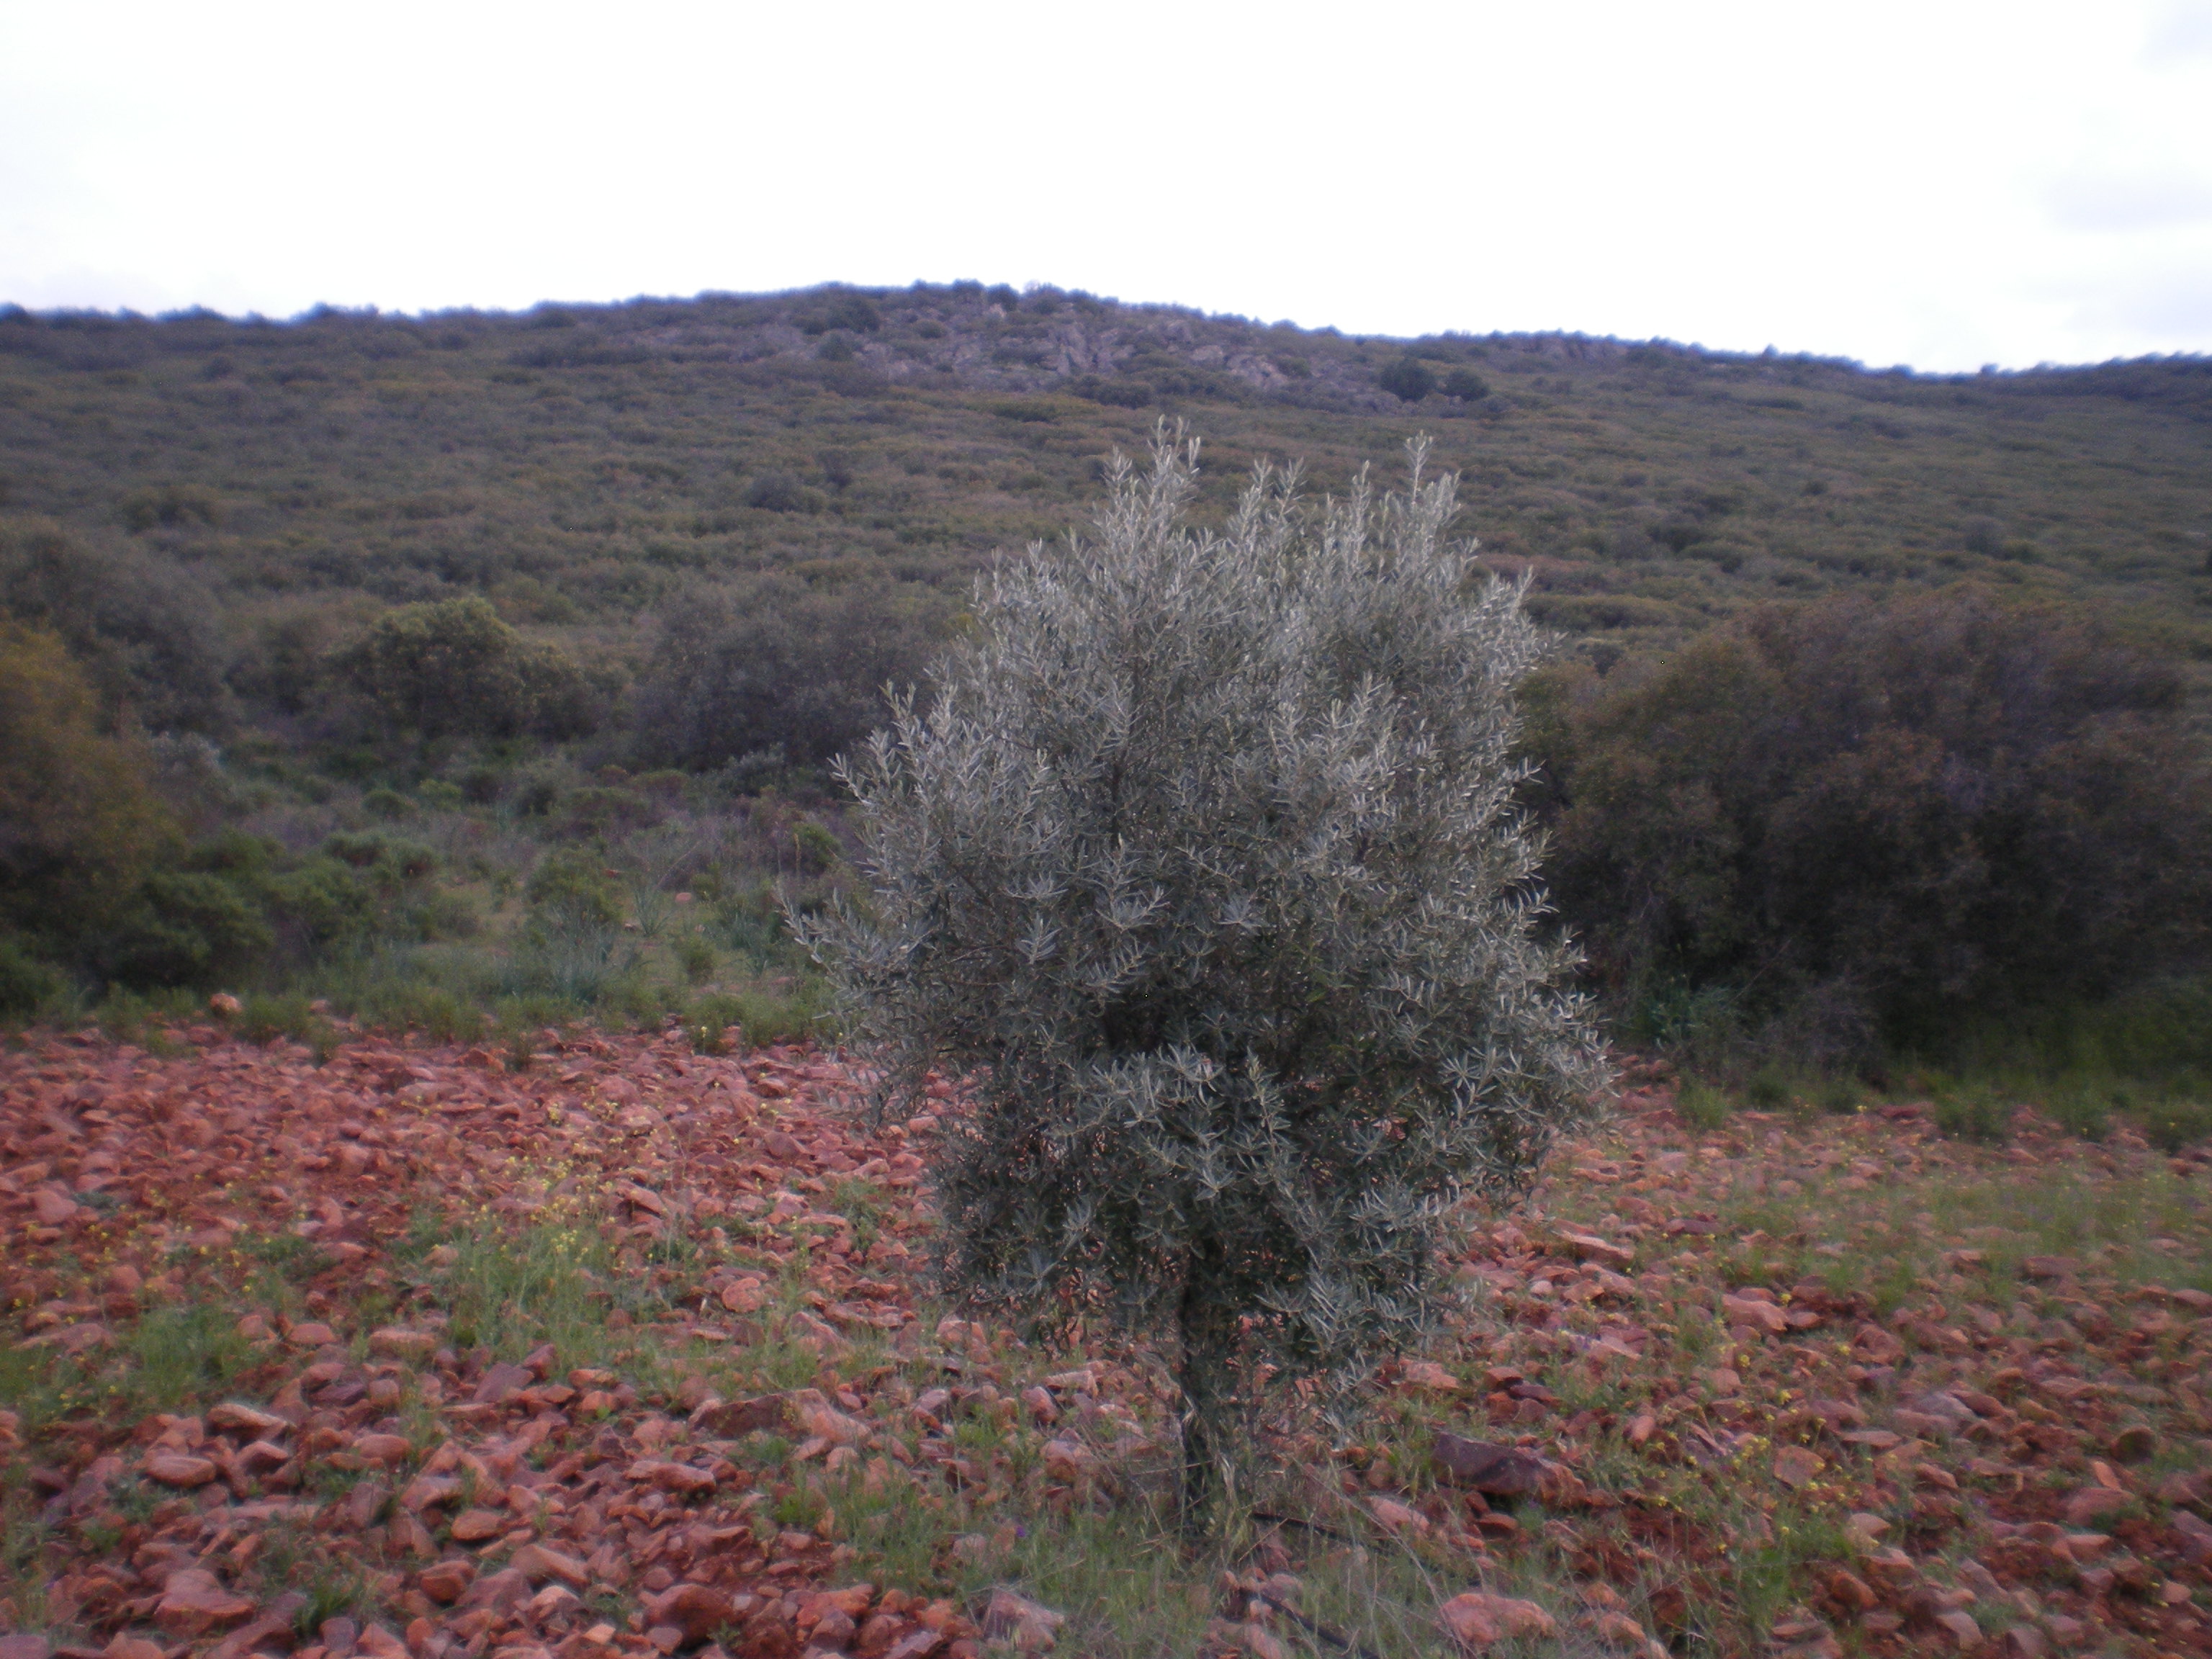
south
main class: Cropland
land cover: Olive groves
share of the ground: 10 - 25 %
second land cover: Spontaneously vegetated surfaces
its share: 25 - 50 %
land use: Agriculture (excluding fallow land and kitchen gardens)
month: April
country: ES
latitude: 38.8636
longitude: -3.5557
